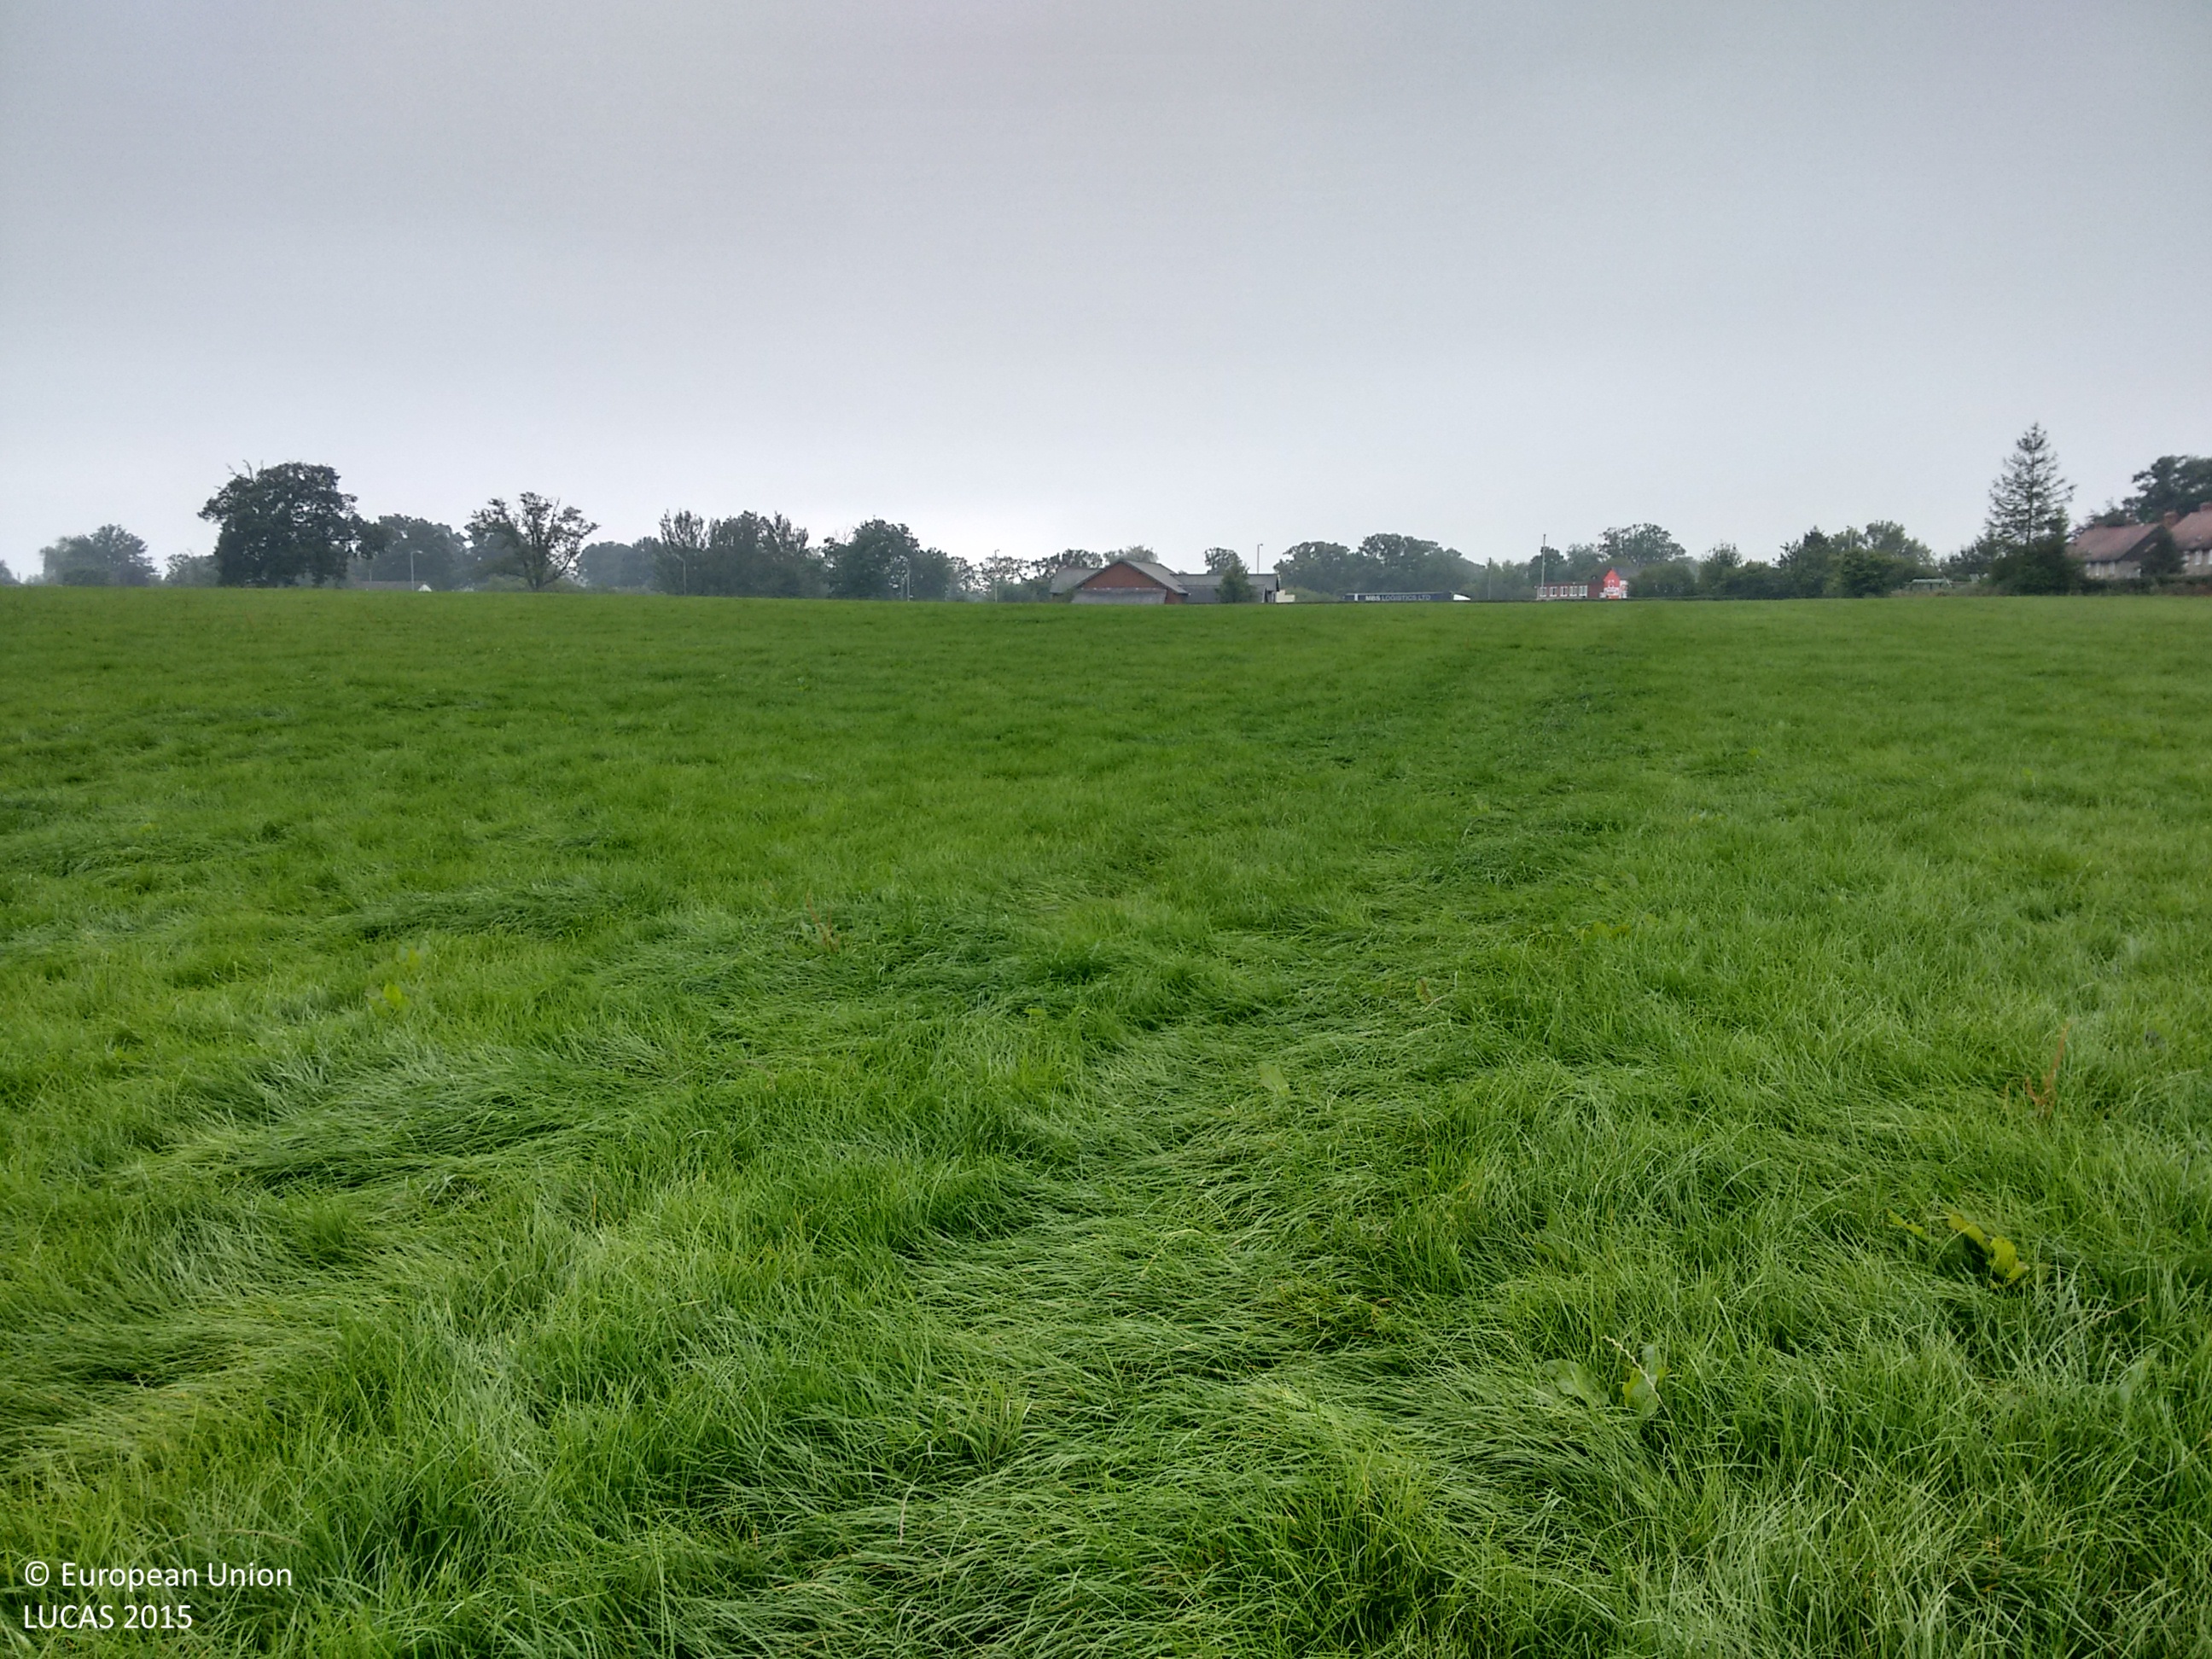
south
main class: Grassland
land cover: Grassland without tree/shrub cover
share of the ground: > 75 %
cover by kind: herbaceous plants 100 %
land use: Agriculture (excluding fallow land and kitchen gardens)
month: September
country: GB
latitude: 52.7013
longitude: -2.9637
